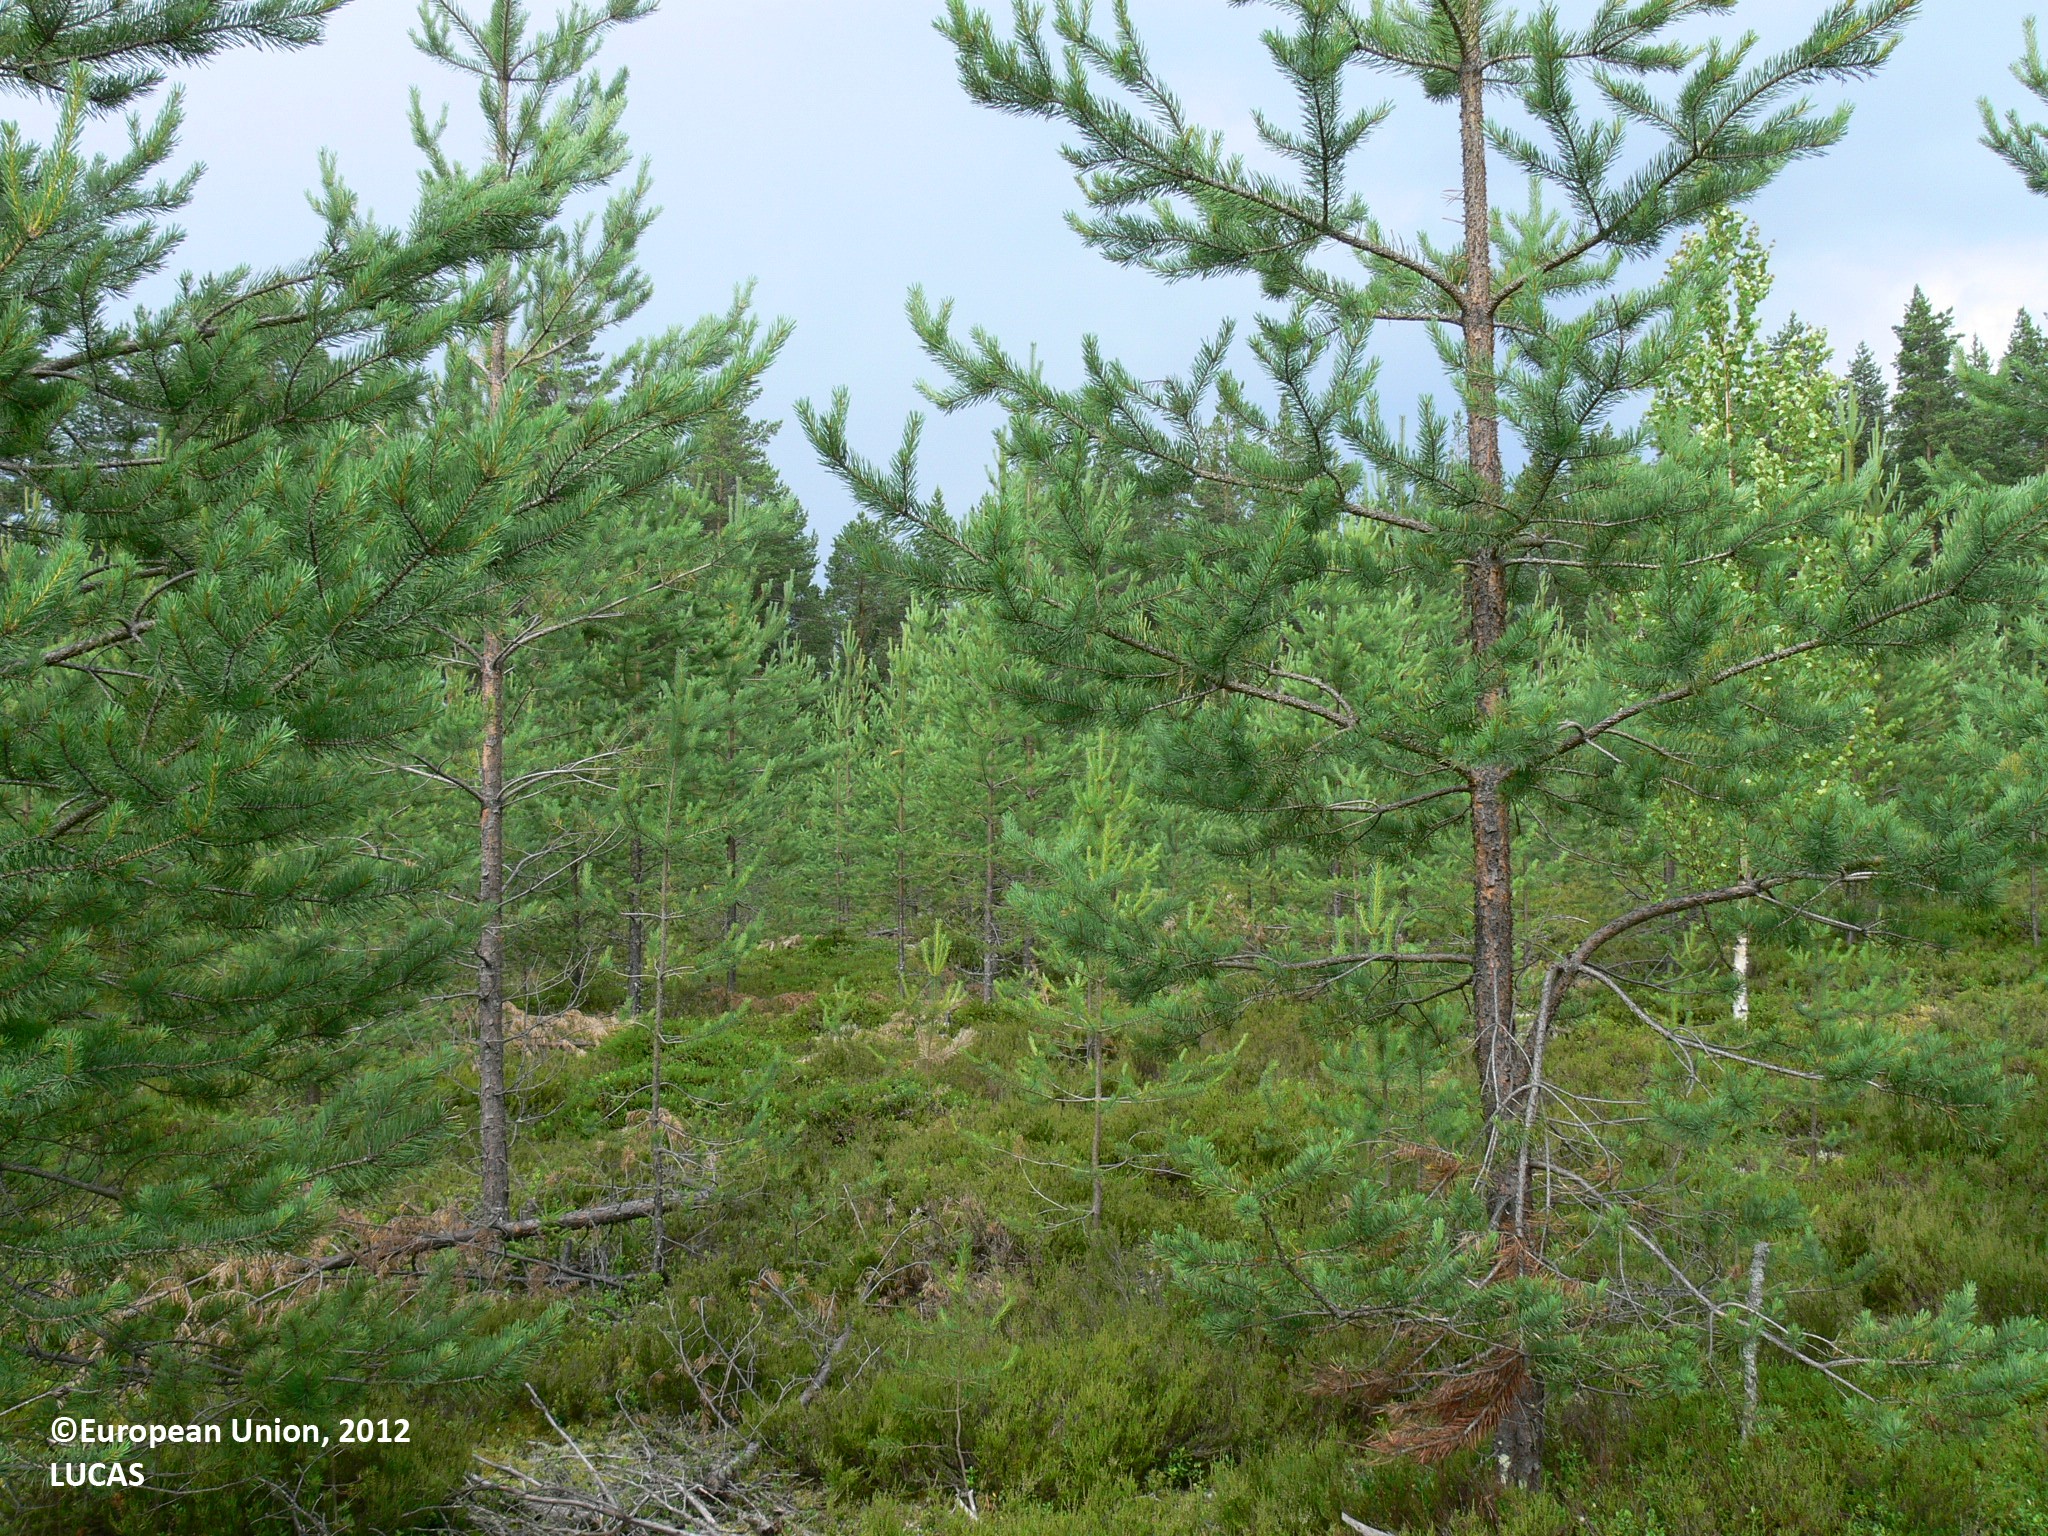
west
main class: Woodland
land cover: Pine dominated coniferous woodland
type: boreal forest
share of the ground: 25 - 50 %
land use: Forestry
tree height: < 5 m
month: July
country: FI
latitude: 63.0835
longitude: 29.9938
